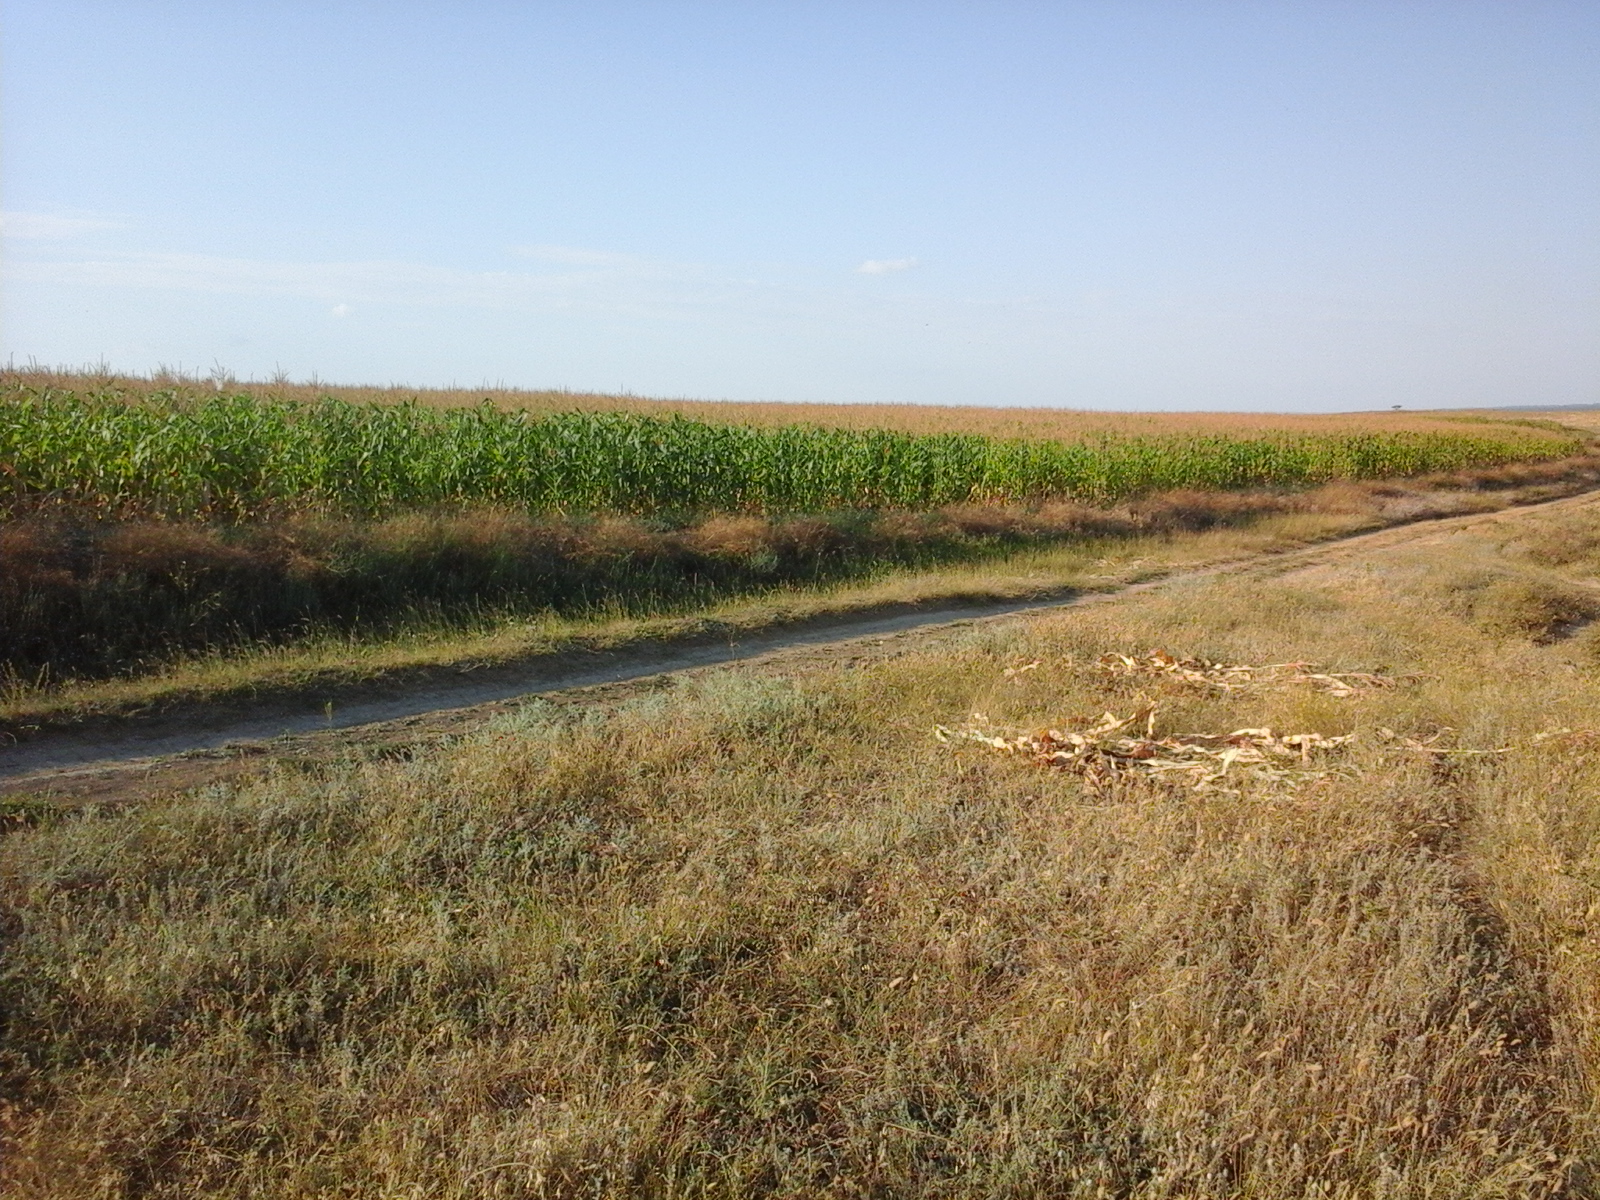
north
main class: Grassland
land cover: Grassland without tree/shrub cover
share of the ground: > 75 %
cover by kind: herbaceous plants 100 %
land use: Agriculture (excluding fallow land and kitchen gardens)
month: August
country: RO
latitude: 44.8220
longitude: 28.9479
